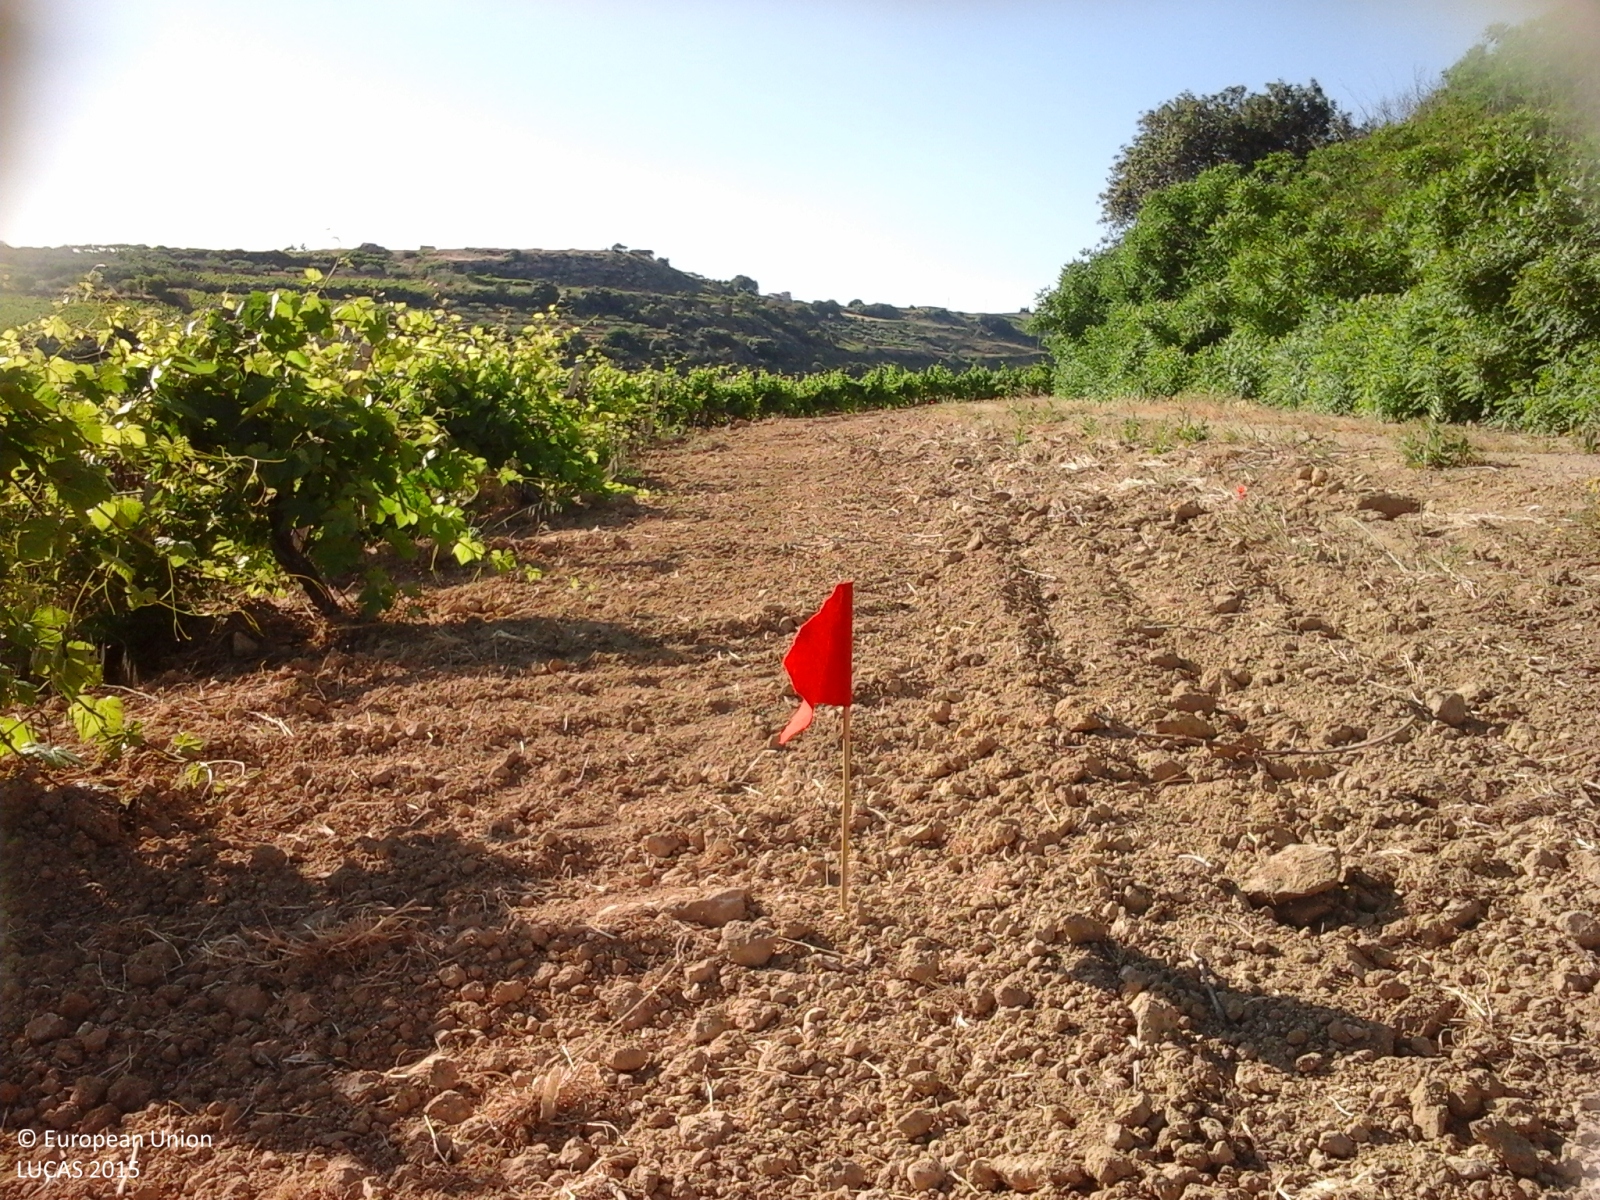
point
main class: Cropland
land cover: Vineyards
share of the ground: 10 - 25 %
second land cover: Other bare soil
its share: > 75 %
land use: Agriculture (excluding fallow land and kitchen gardens)
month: May
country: IT
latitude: 37.6093
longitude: 13.0018
